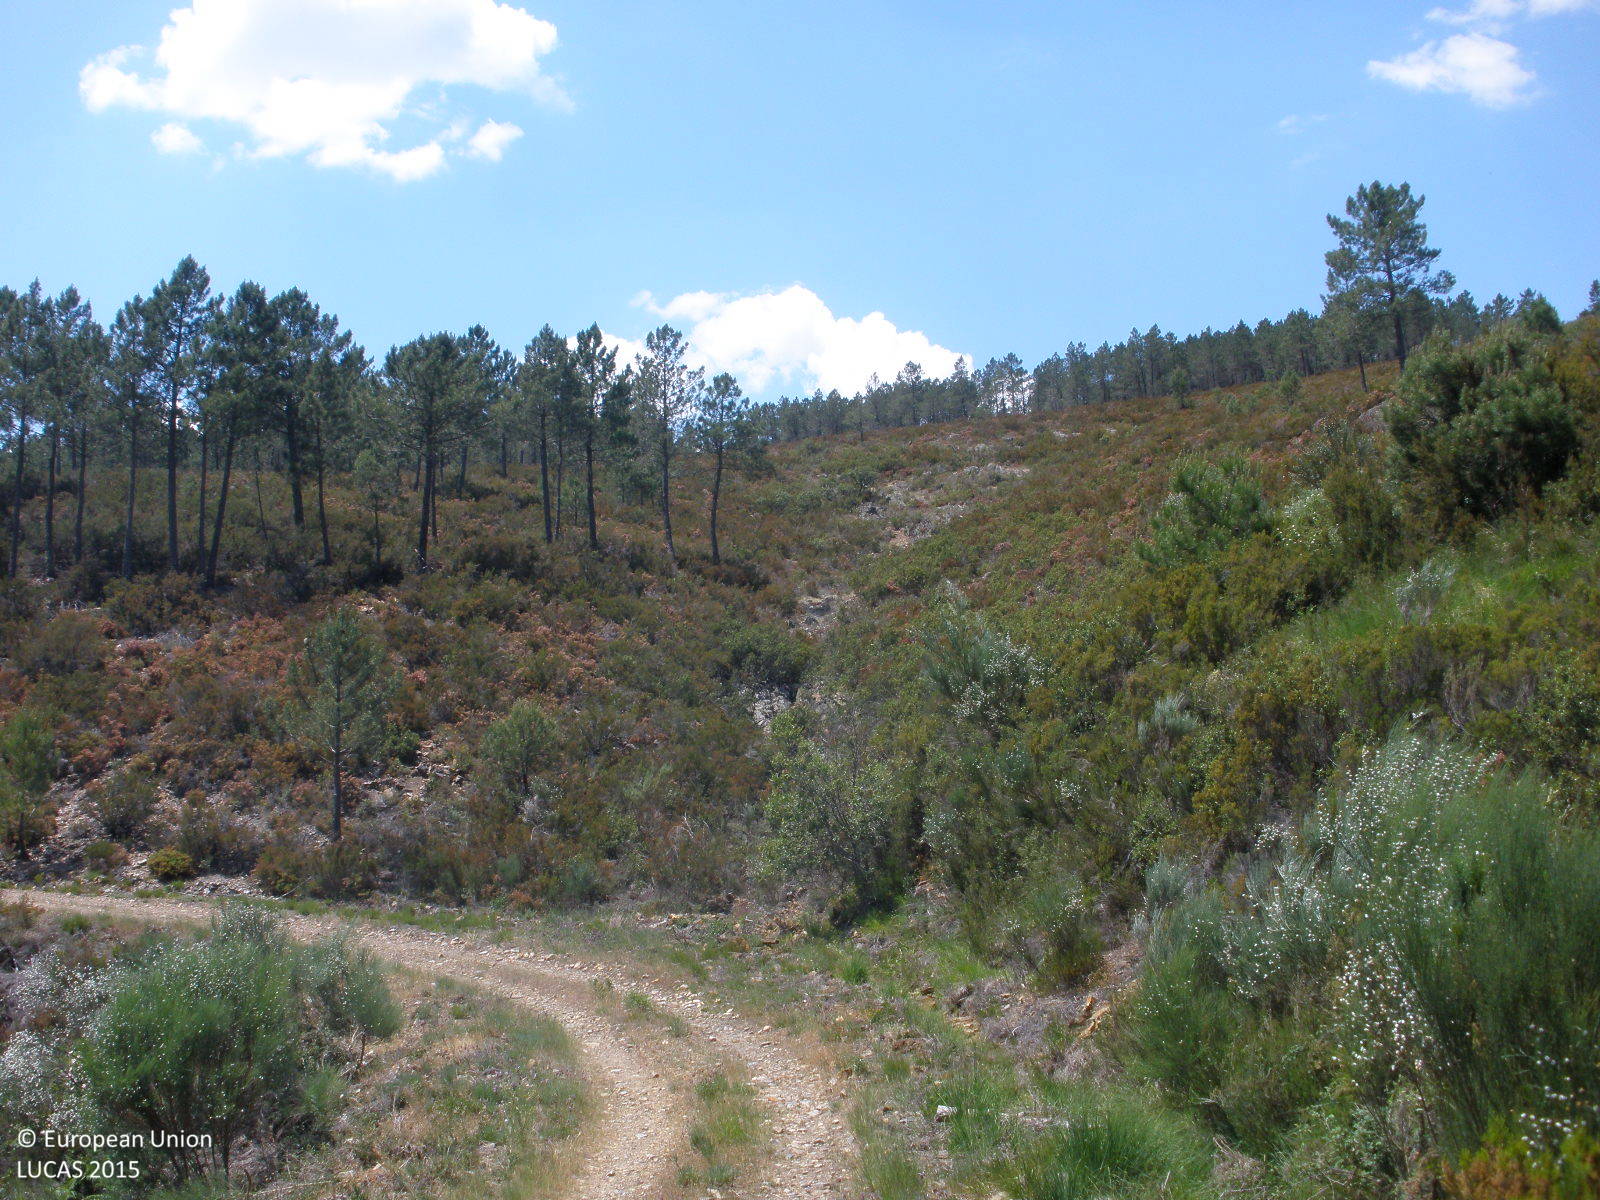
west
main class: Shrubland
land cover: Shrubland with sparse tree cover
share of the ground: > 75 %
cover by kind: shrubs 95 %, coniferous forest trees 5 %
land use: Forestry
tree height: < 5 m
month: June
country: ES
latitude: 40.5059
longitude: -6.2373
